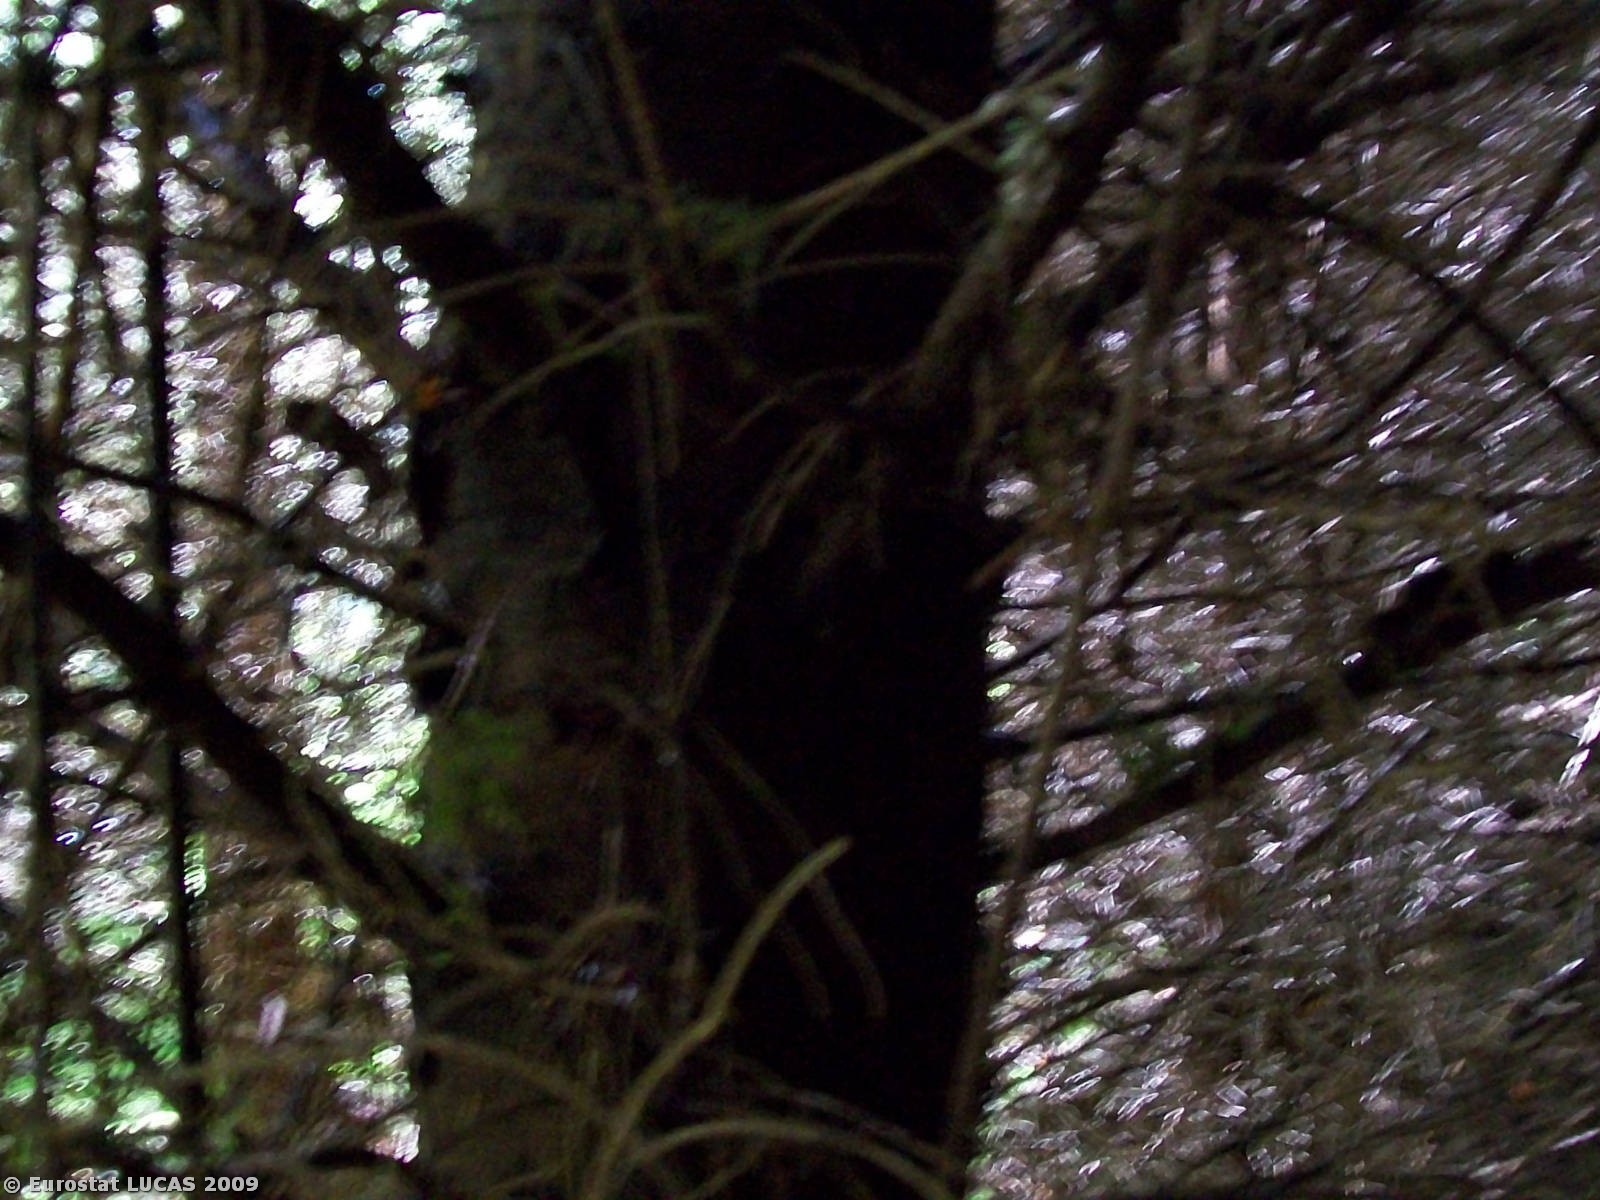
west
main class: Woodland
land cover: Coniferous woodland
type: plantations and self-sown exotic forest
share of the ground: > 75 %
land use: Forestry
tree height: > 5 m
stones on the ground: < 10 %
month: May
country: IE
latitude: 51.8356
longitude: -8.7957
